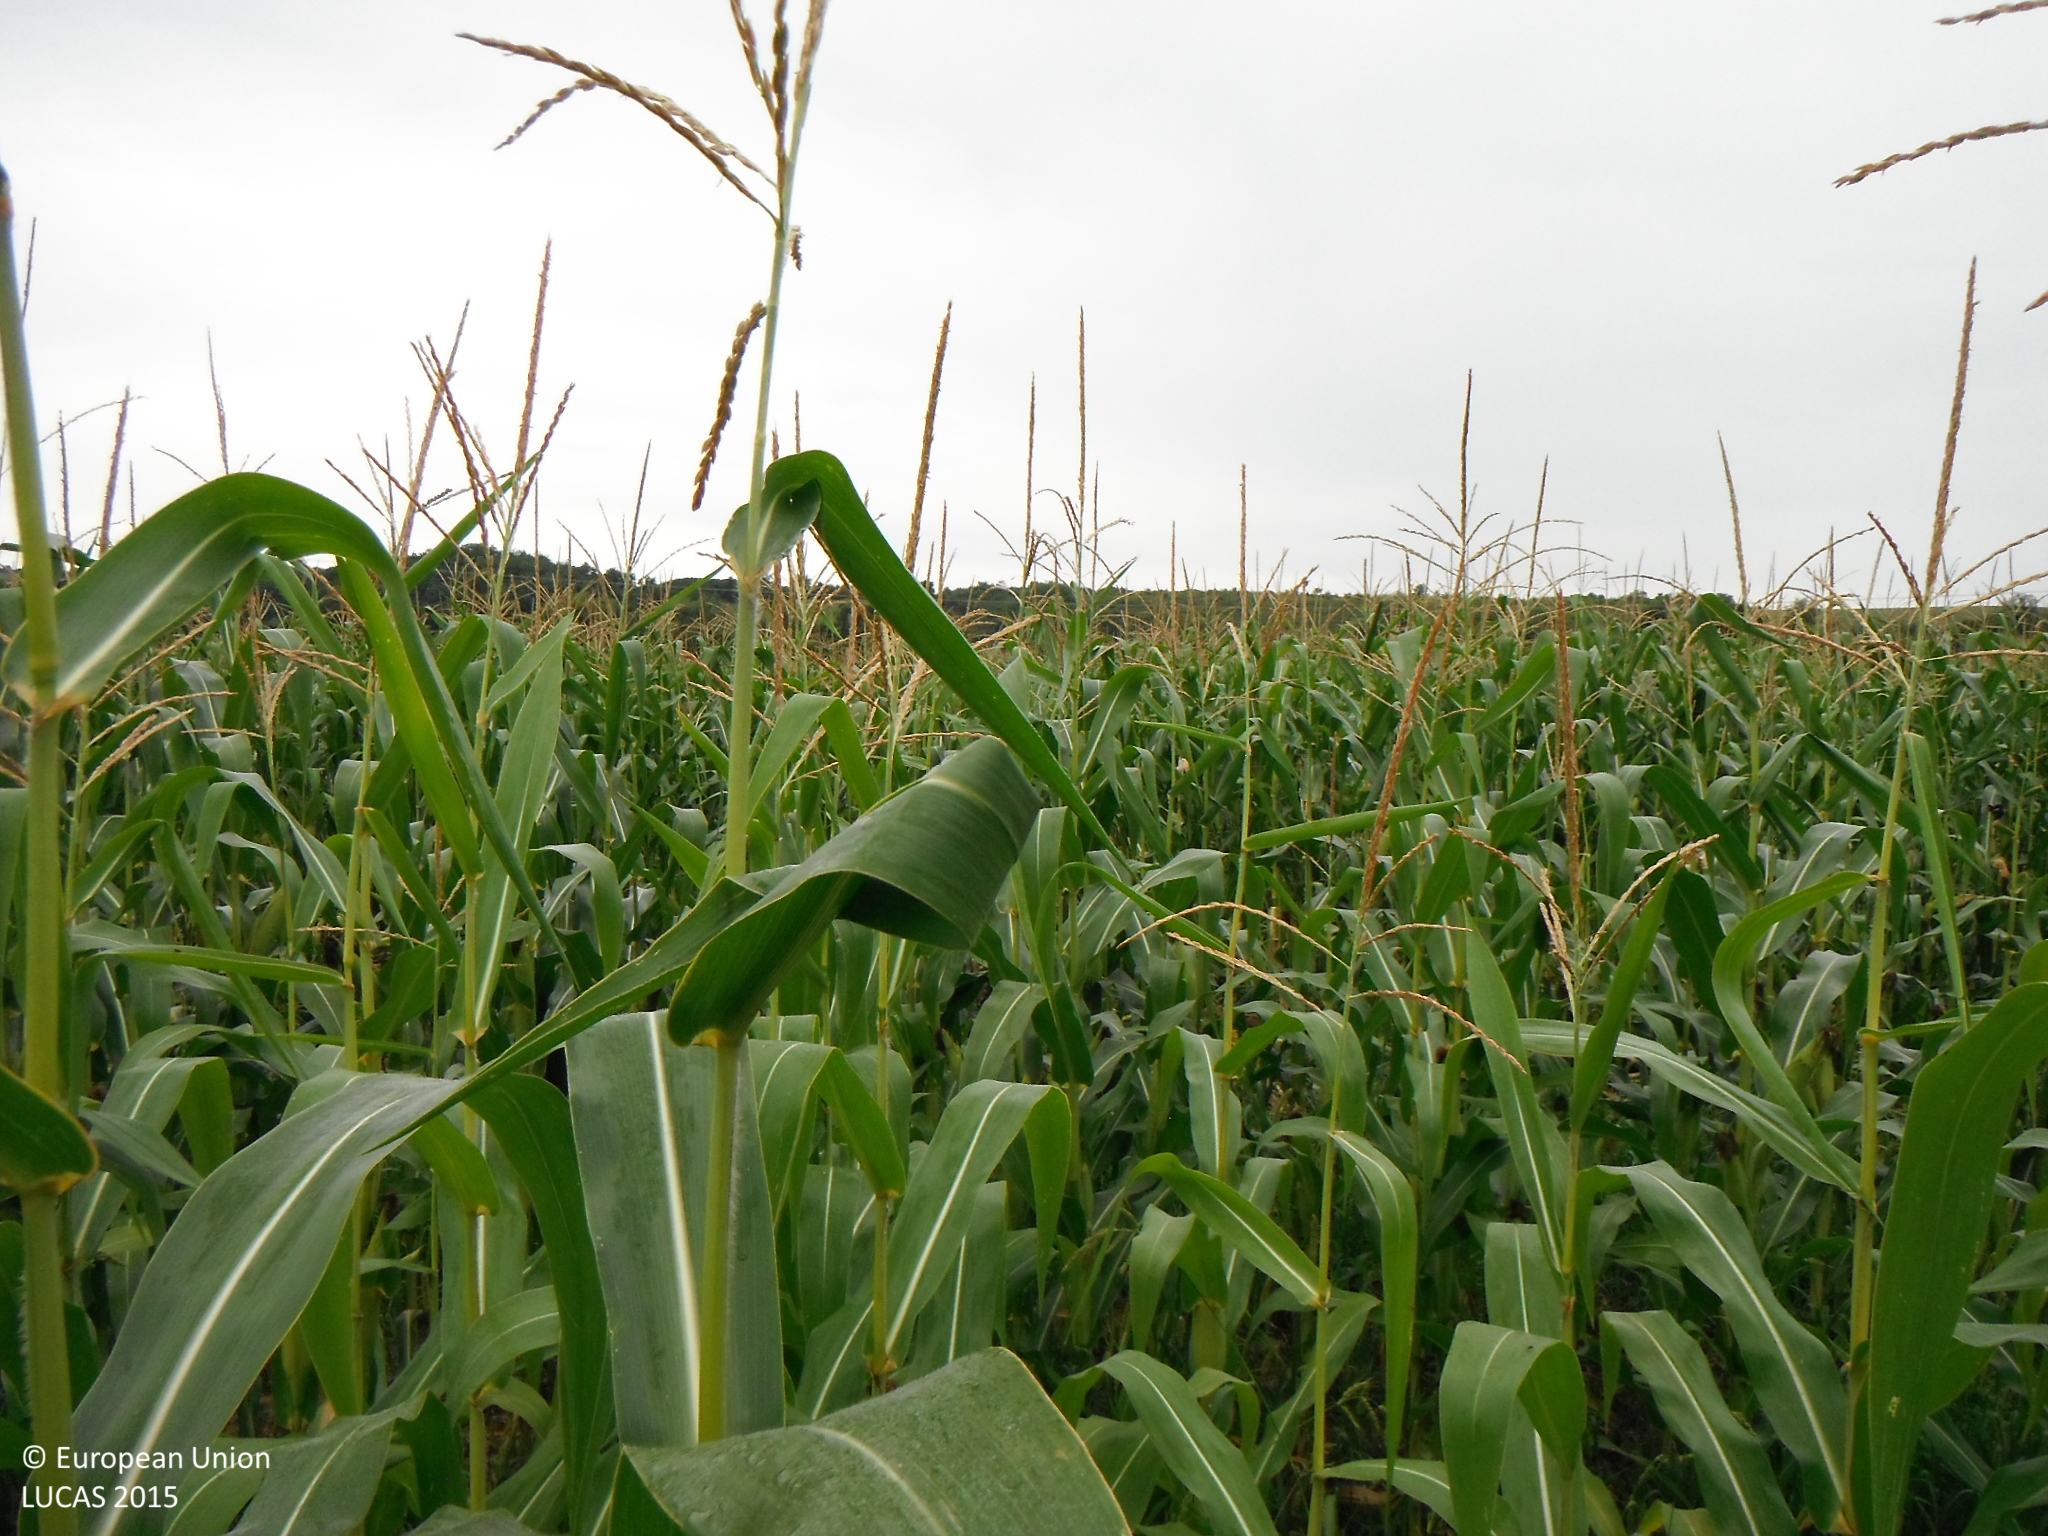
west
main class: Cropland
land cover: Maize
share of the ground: > 75 %
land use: Agriculture (excluding fallow land and kitchen gardens)
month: July
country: SK
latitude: 48.2352
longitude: 19.8423
